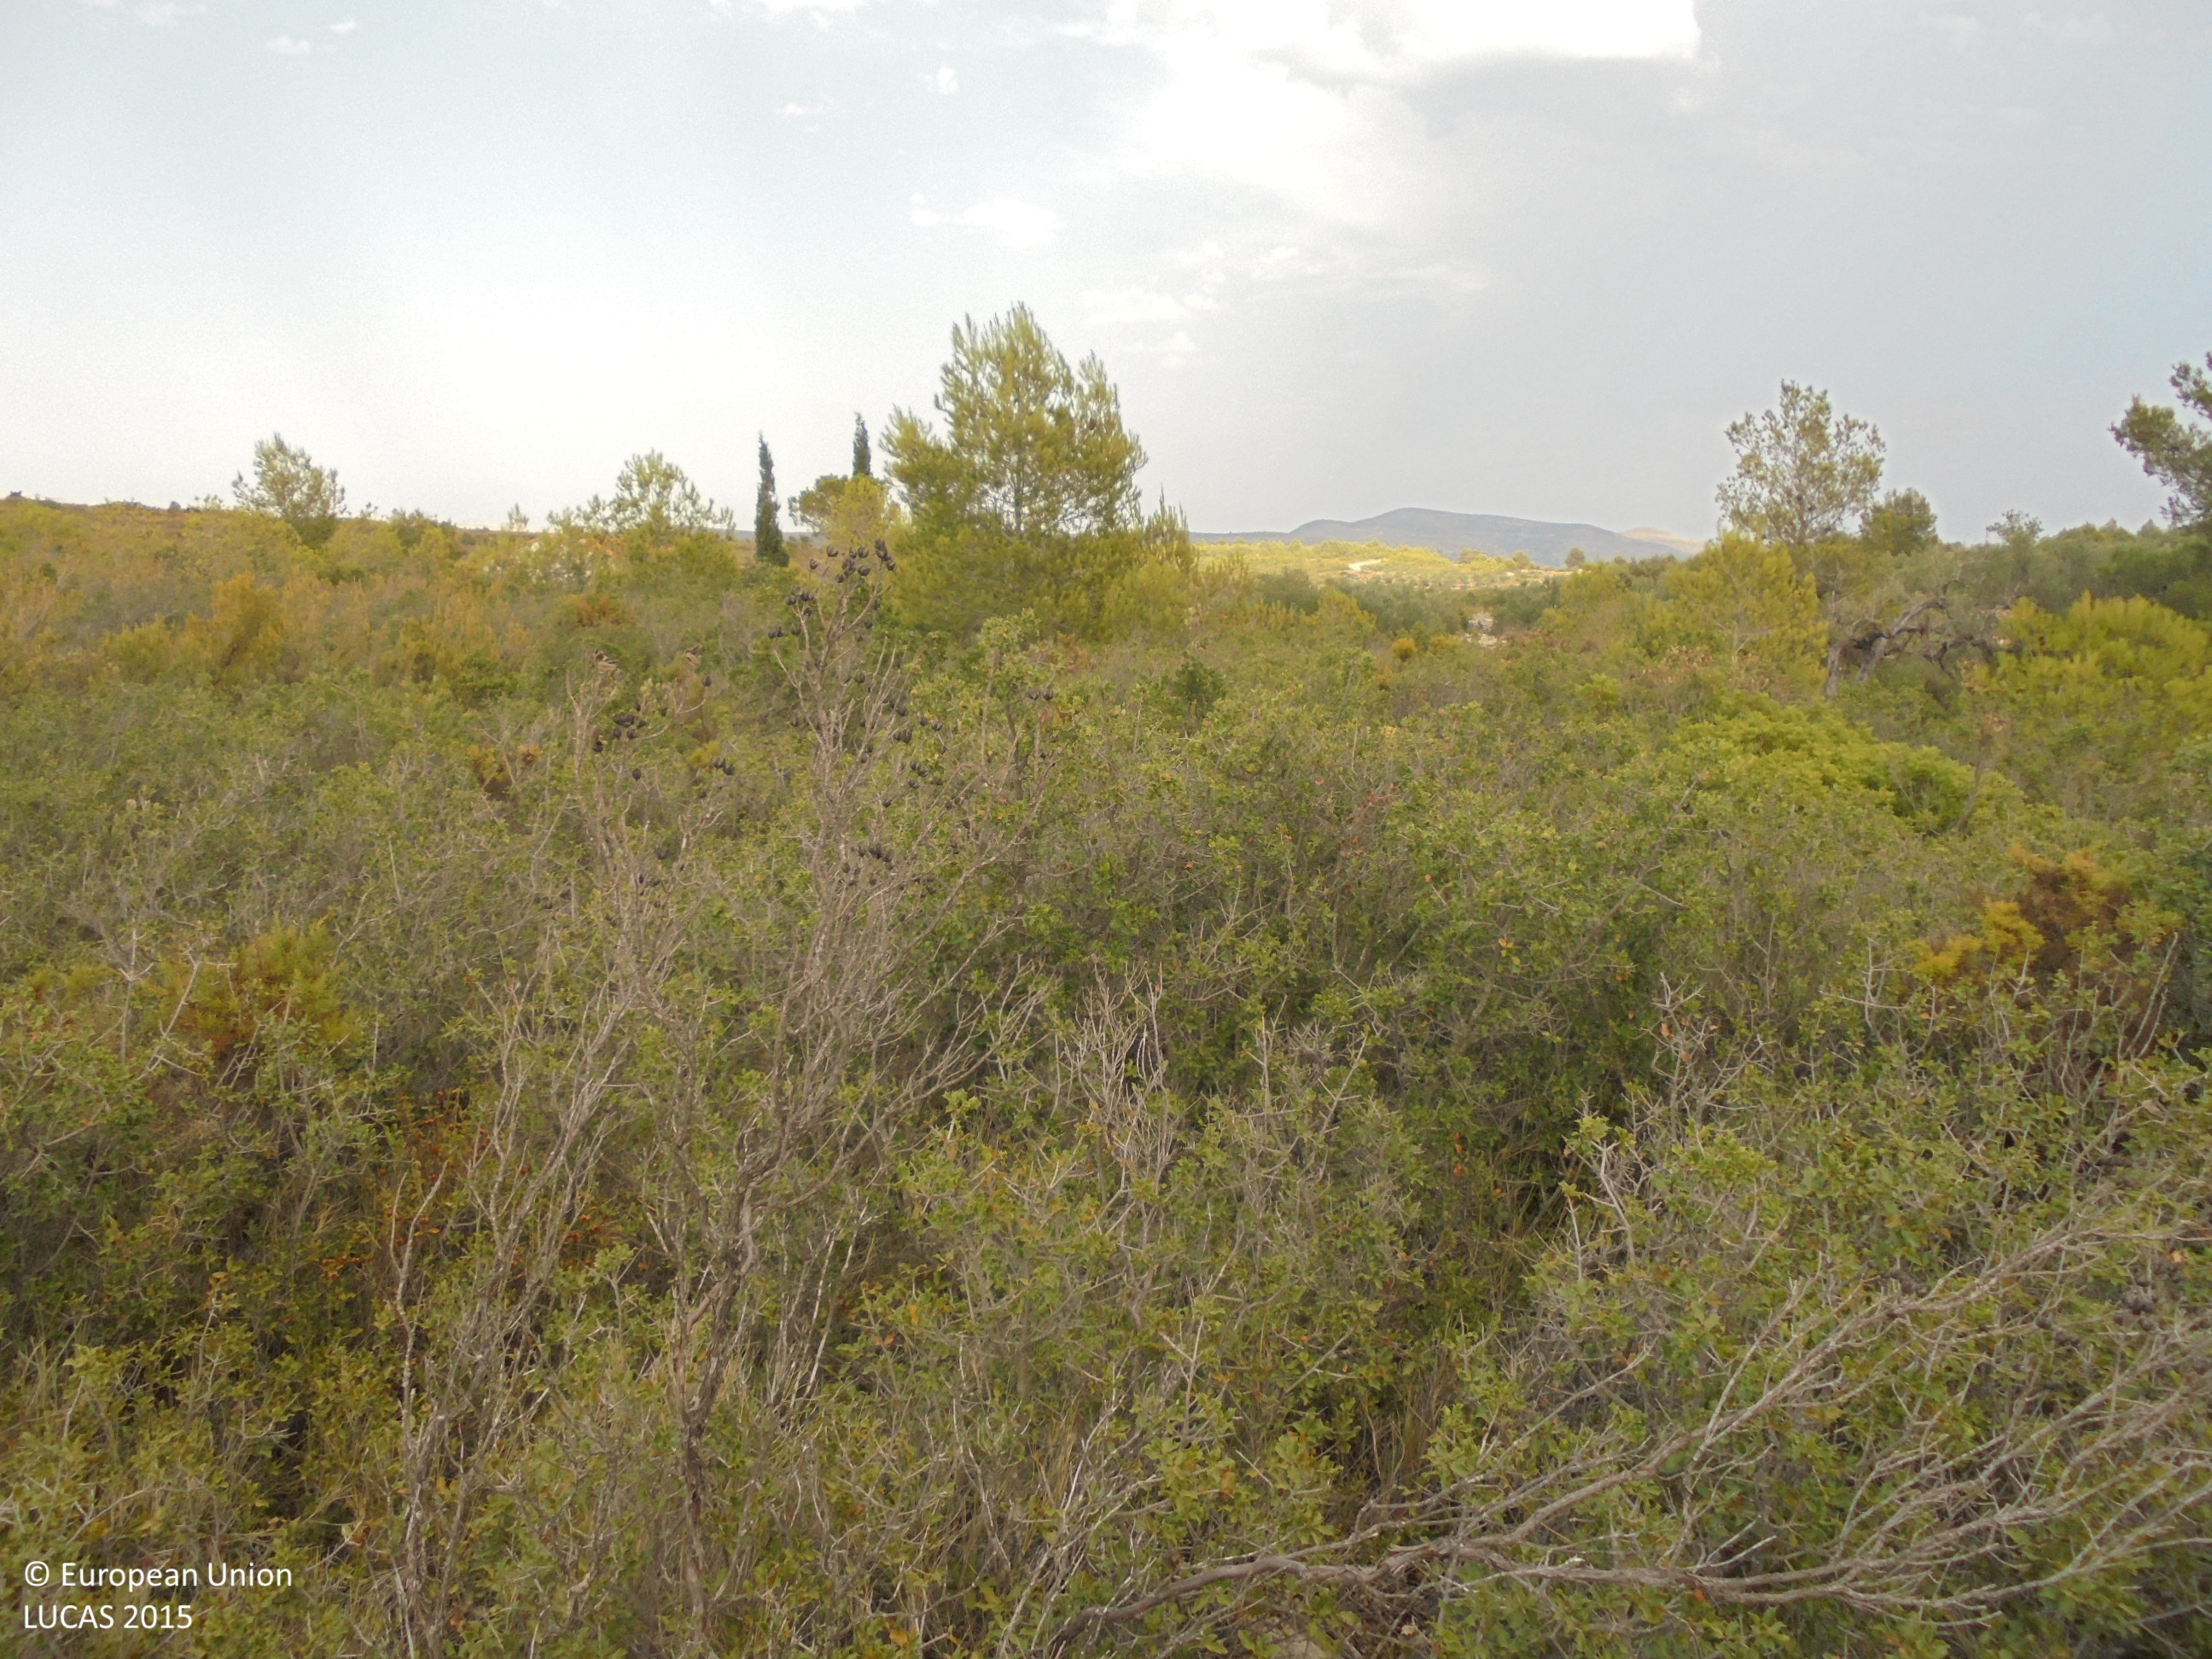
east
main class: Shrubland
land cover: Shrubland with sparse tree cover
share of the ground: > 75 %
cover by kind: shrubs 90 %, coniferous forest trees 5 %, unconsolidated bare surface 5 %
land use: Semi-natural and natural areas not in use
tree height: > 5 m
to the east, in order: Shrubland with sparse tree cover; Dry stone walls; Fences; Artificial constructions in urban areas; Olive groves; Dry stone walls; Olive groves; Dry stone walls; Olive groves; Shrubland with sparse tree cover; Shrubland without tree cover; Dry stone walls; Shrubland without tree cover; Dry stone walls; Shrubland without tree cover; Olive groves; Shrubland without tree cover; Dry stone walls; Shrubland without tree cover
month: July
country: ES
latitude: 39.2155
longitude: -0.7792
